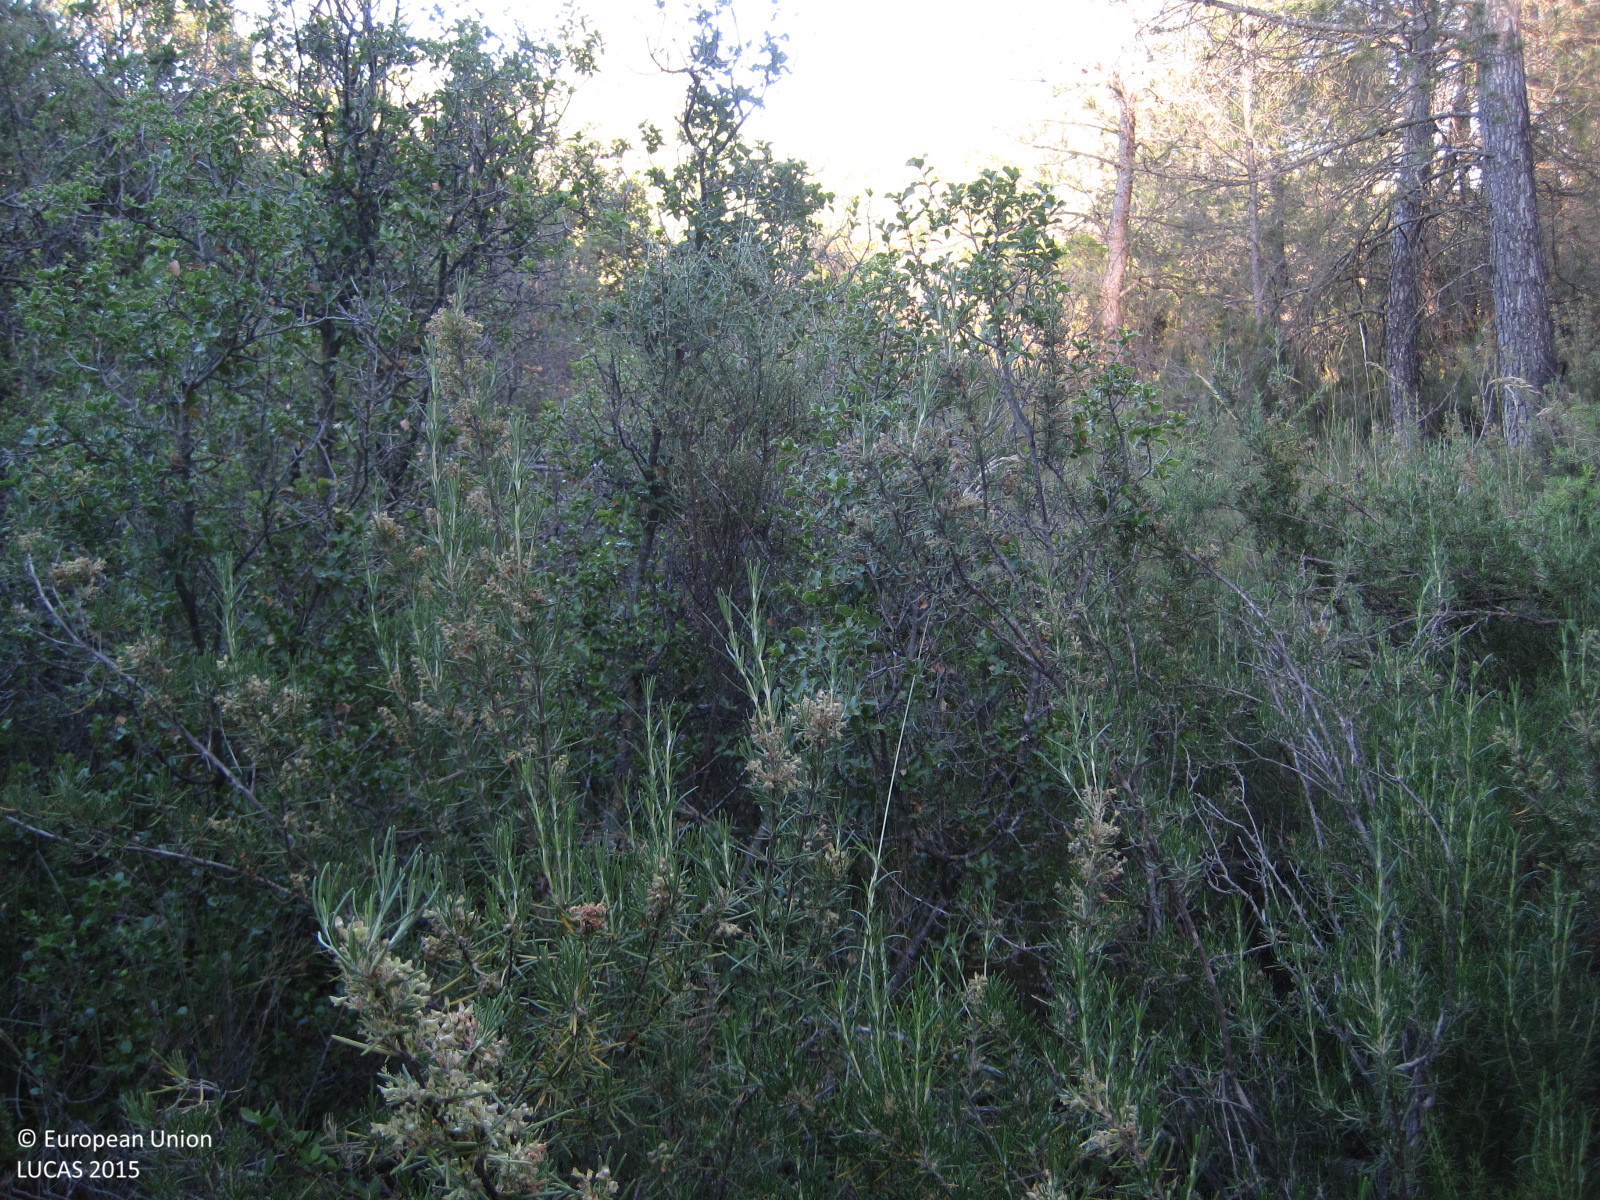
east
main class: Woodland
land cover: Broadleaved woodland
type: broadleaved evergreen forest
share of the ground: 50 - 75 %
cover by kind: broadleaved forest trees 50 %, shrubs 25 %, coniferous forest trees 15 %, herbaceous plants 10 %
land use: Forestry
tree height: > 5 m
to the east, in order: Broadleaved woodland; Pine dominated coniferous woodland
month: May
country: ES
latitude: 39.4378
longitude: -1.0731
